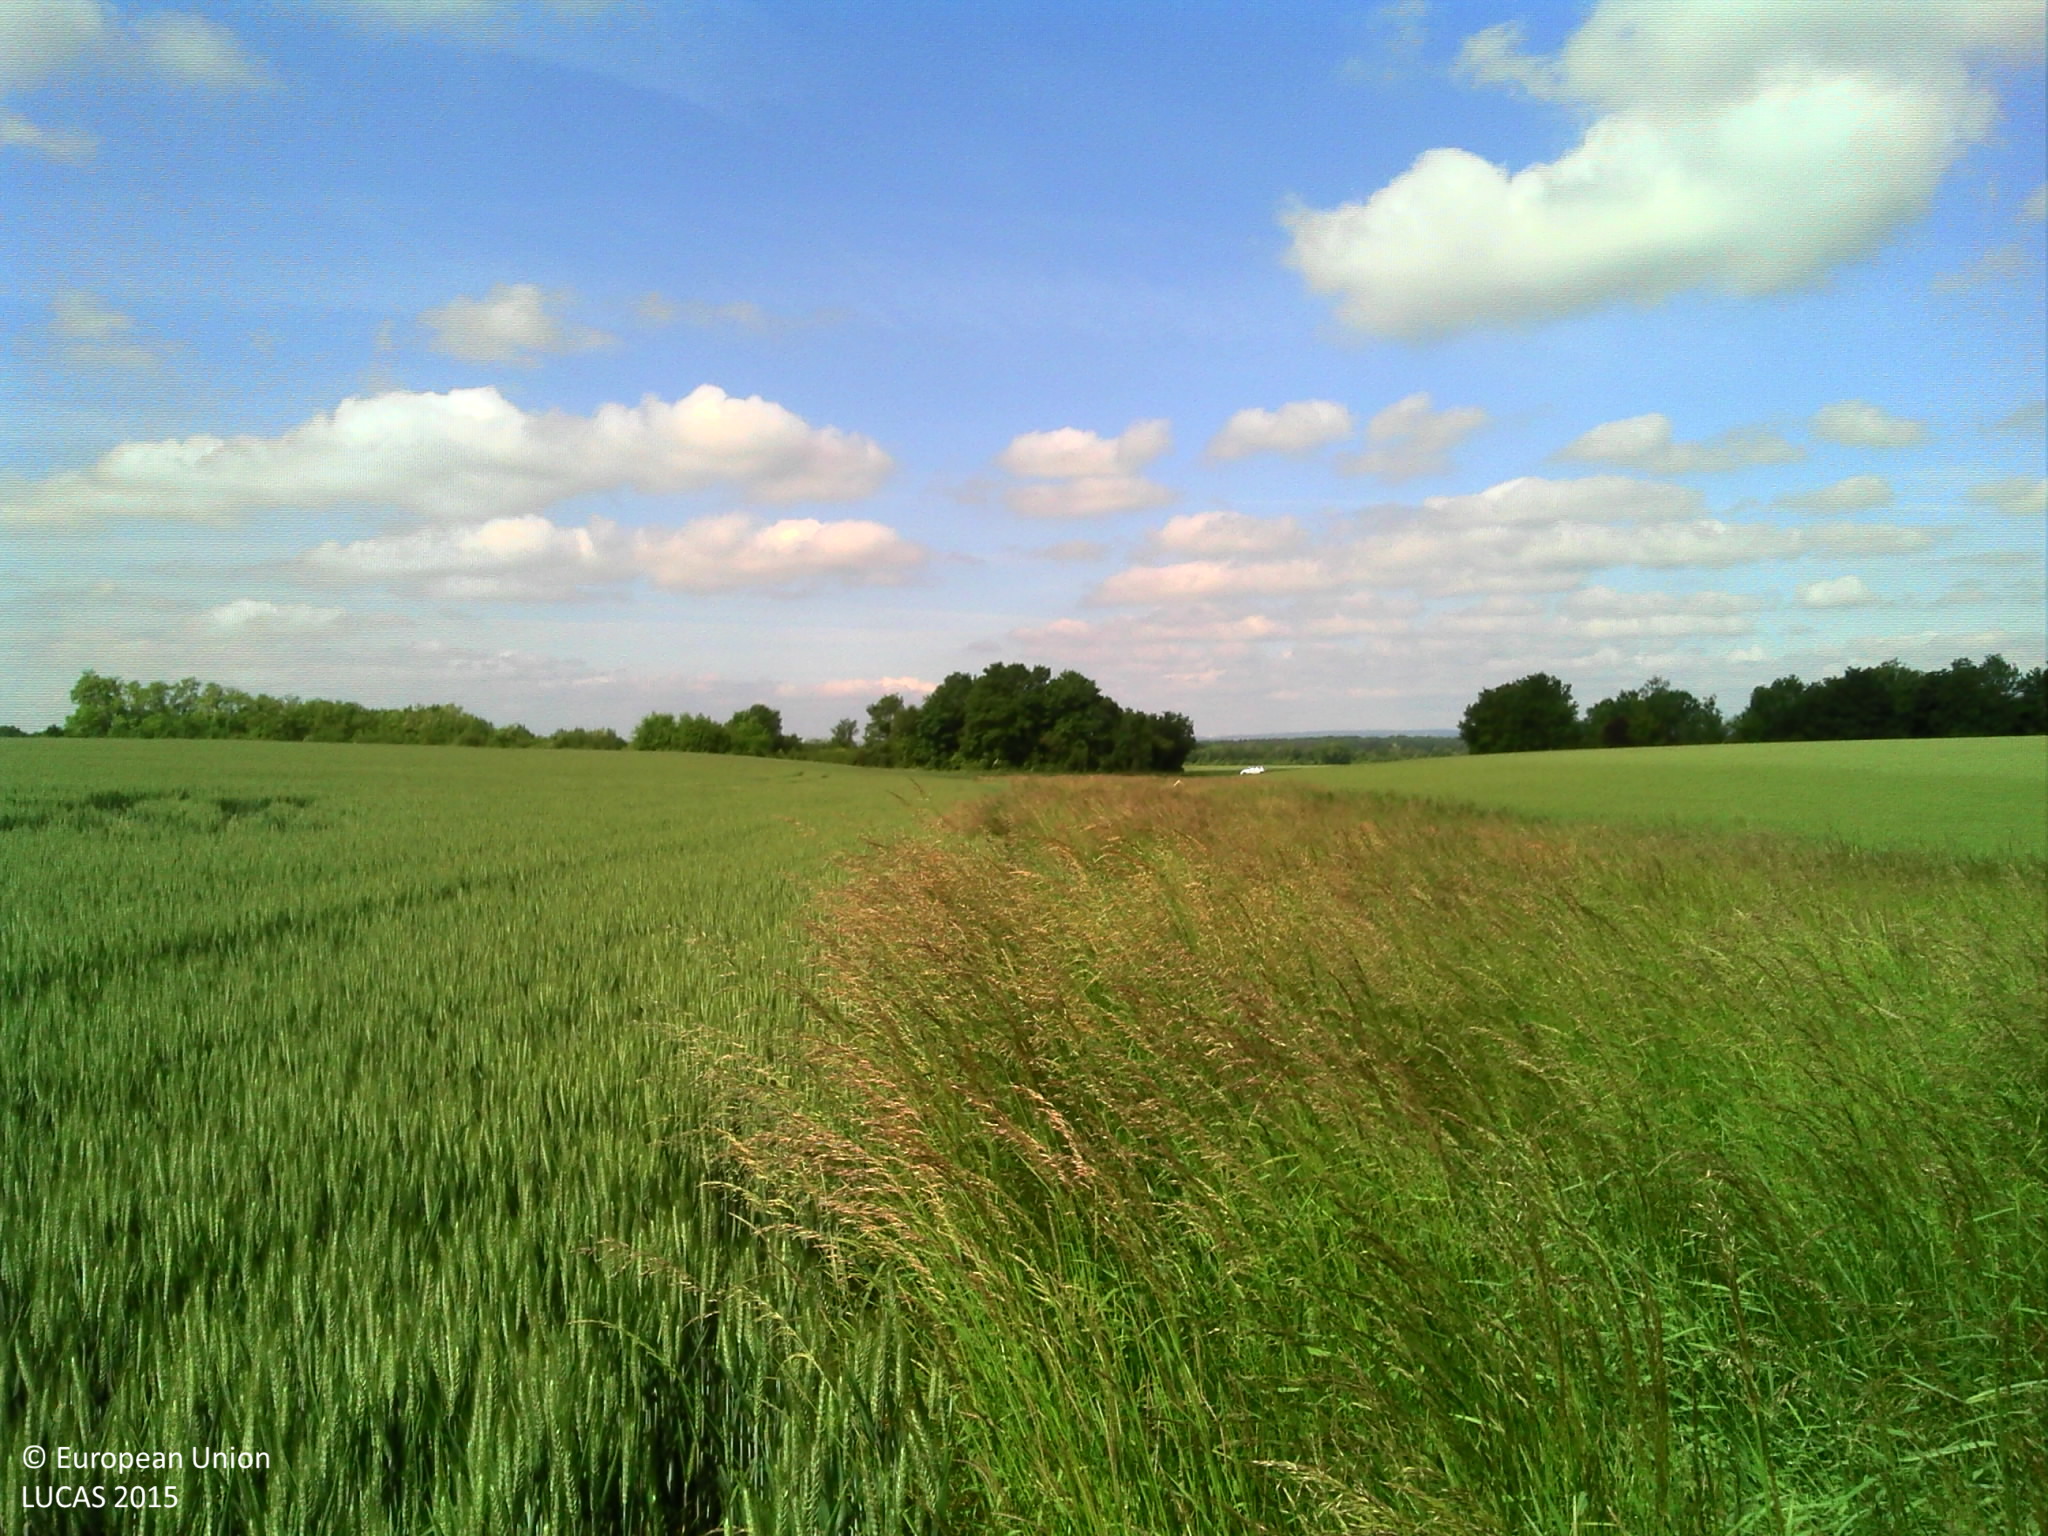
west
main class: Cropland
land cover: Common wheat
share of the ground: > 75 %
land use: Agriculture (excluding fallow land and kitchen gardens)
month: May
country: FR
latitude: 47.4346
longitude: 5.2141
